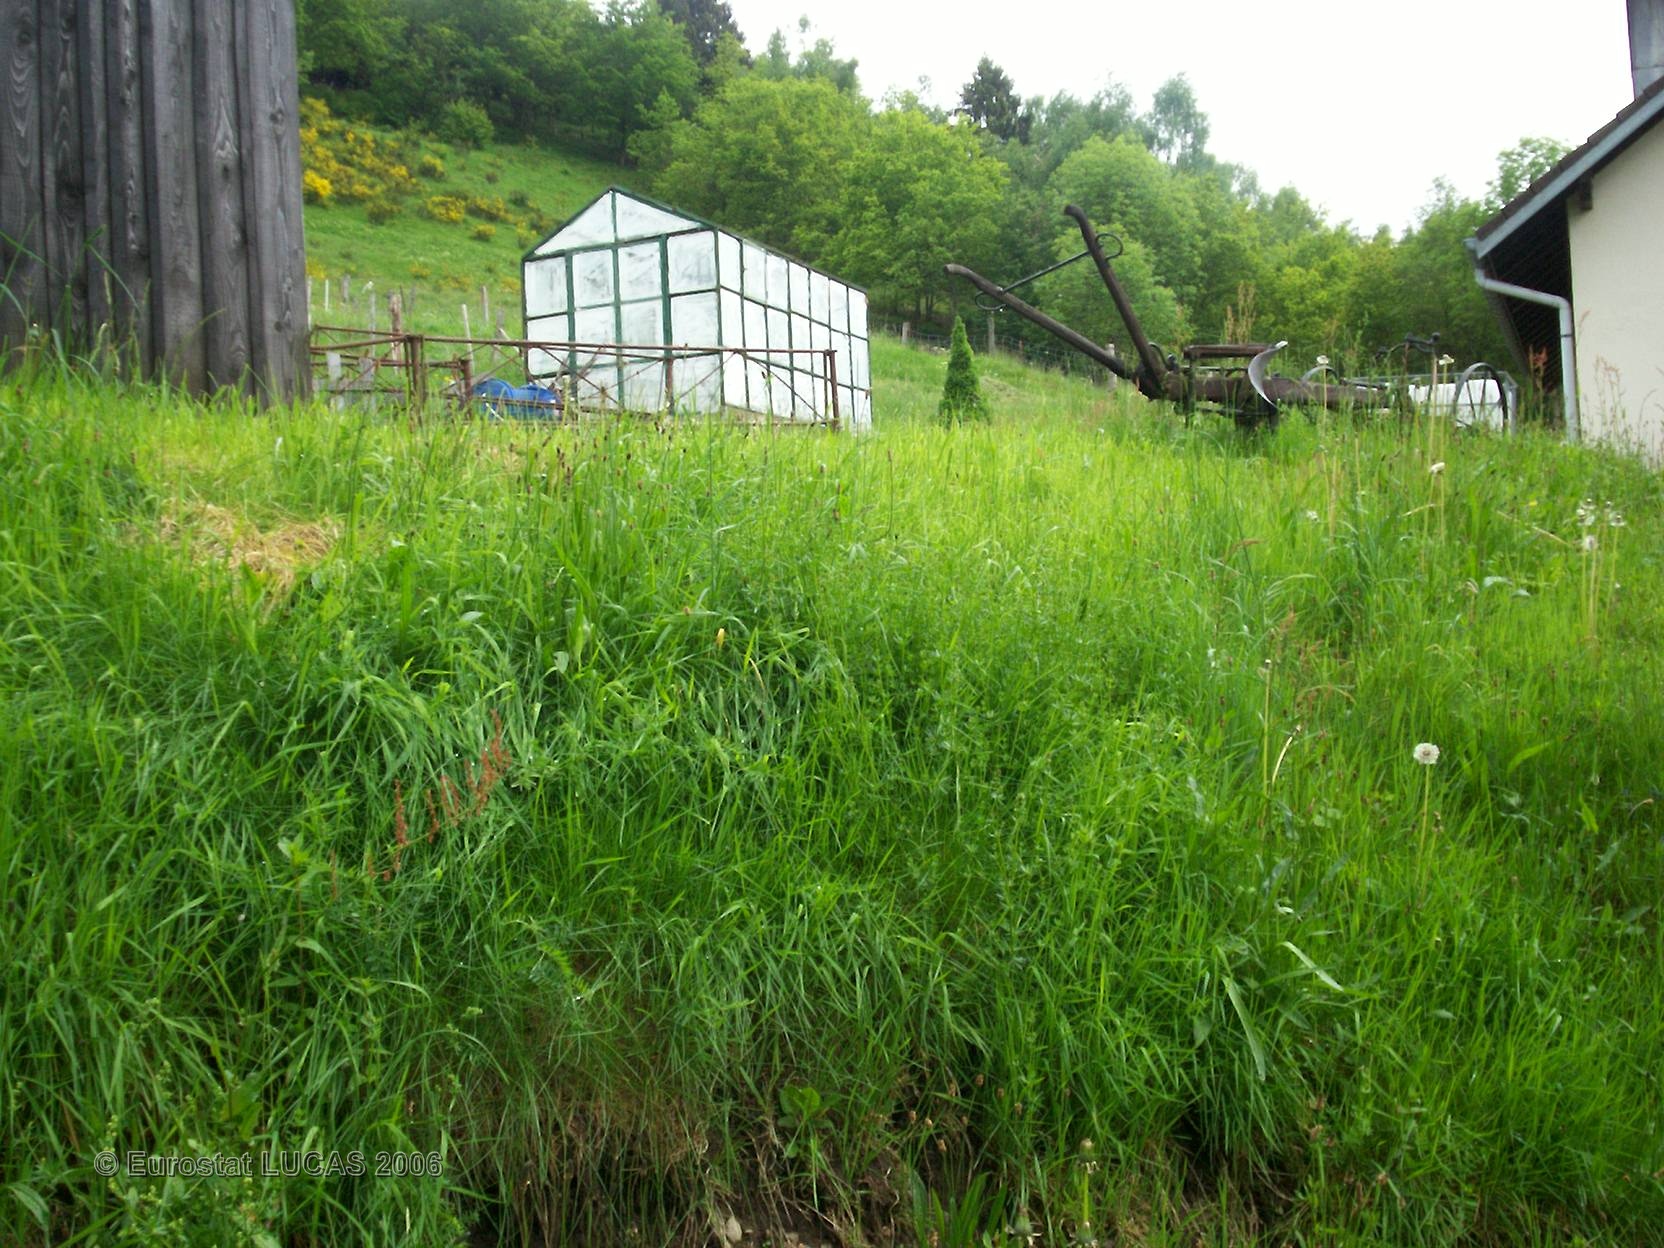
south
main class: Grassland
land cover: Grassland with sparse tree/shrub cover
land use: Agriculture (excluding fallow land and kitchen gardens)
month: June
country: FR
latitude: 47.8883
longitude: 6.7781
